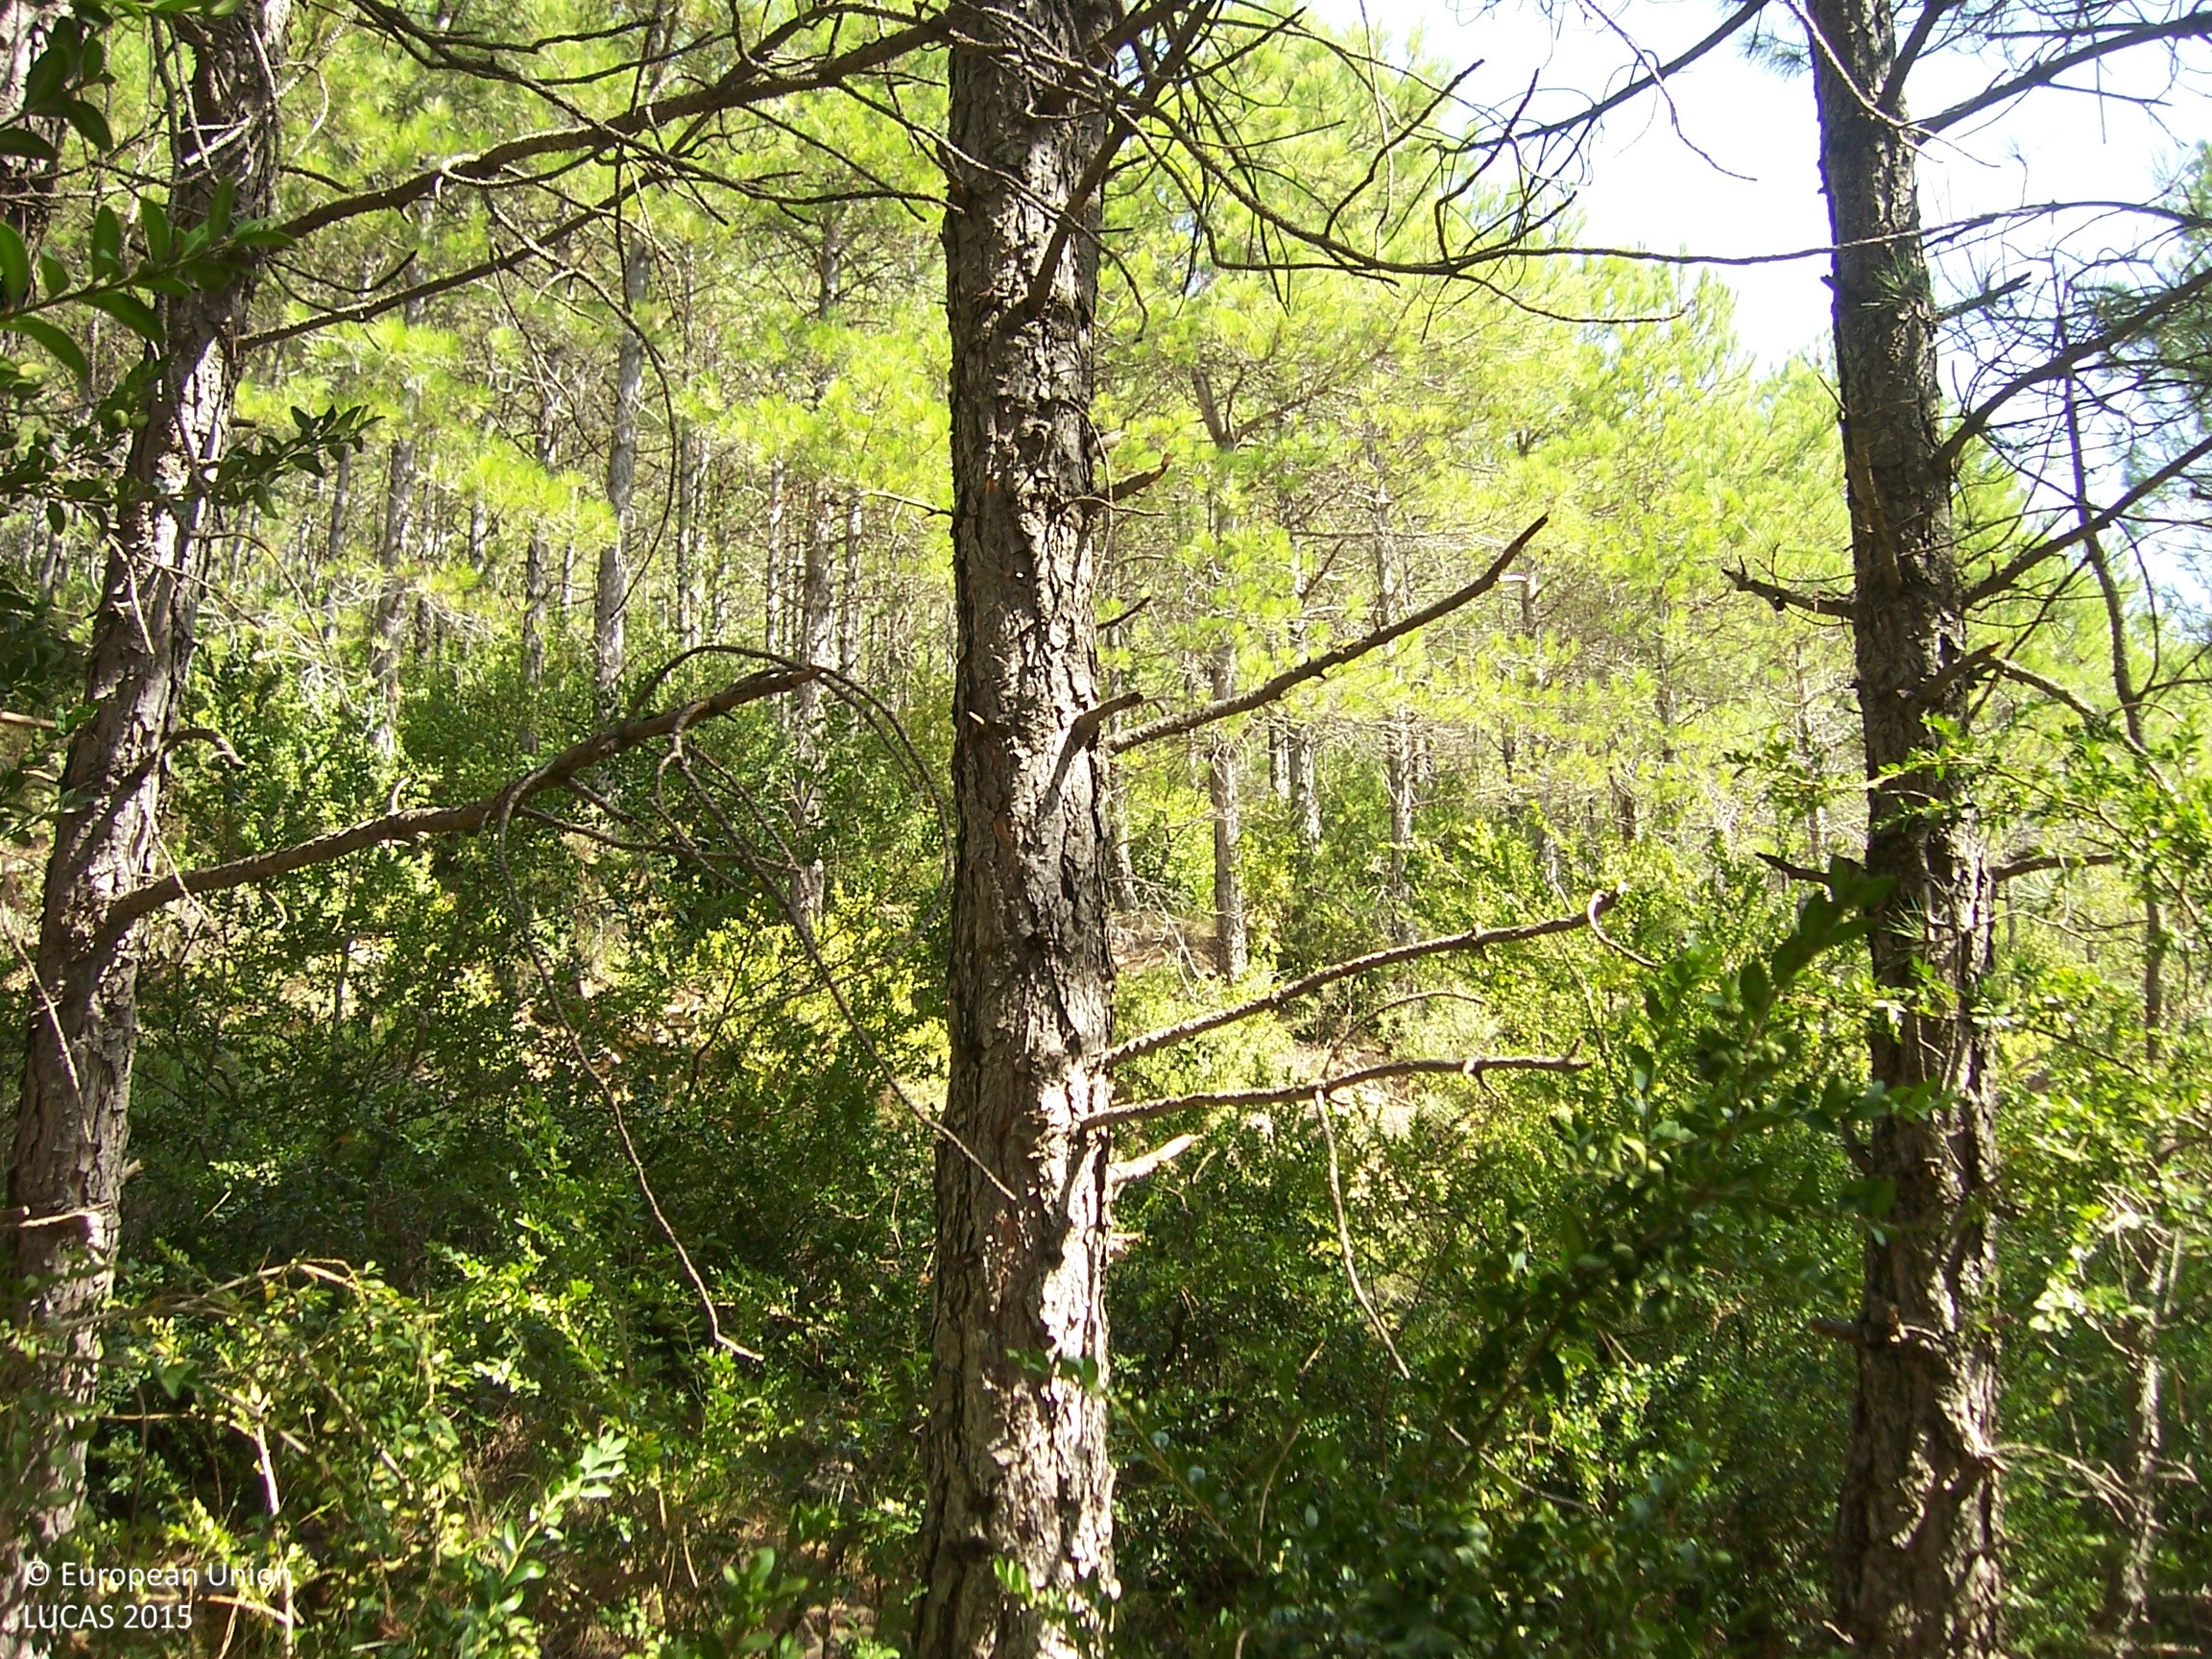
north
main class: Woodland
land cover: Pine dominated coniferous woodland
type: coniferous forest of the mediterranean region
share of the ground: > 75 %
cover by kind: coniferous forest trees 100 %
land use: Forestry
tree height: > 5 m
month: August
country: ES
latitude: 42.5856
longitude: -0.4448
